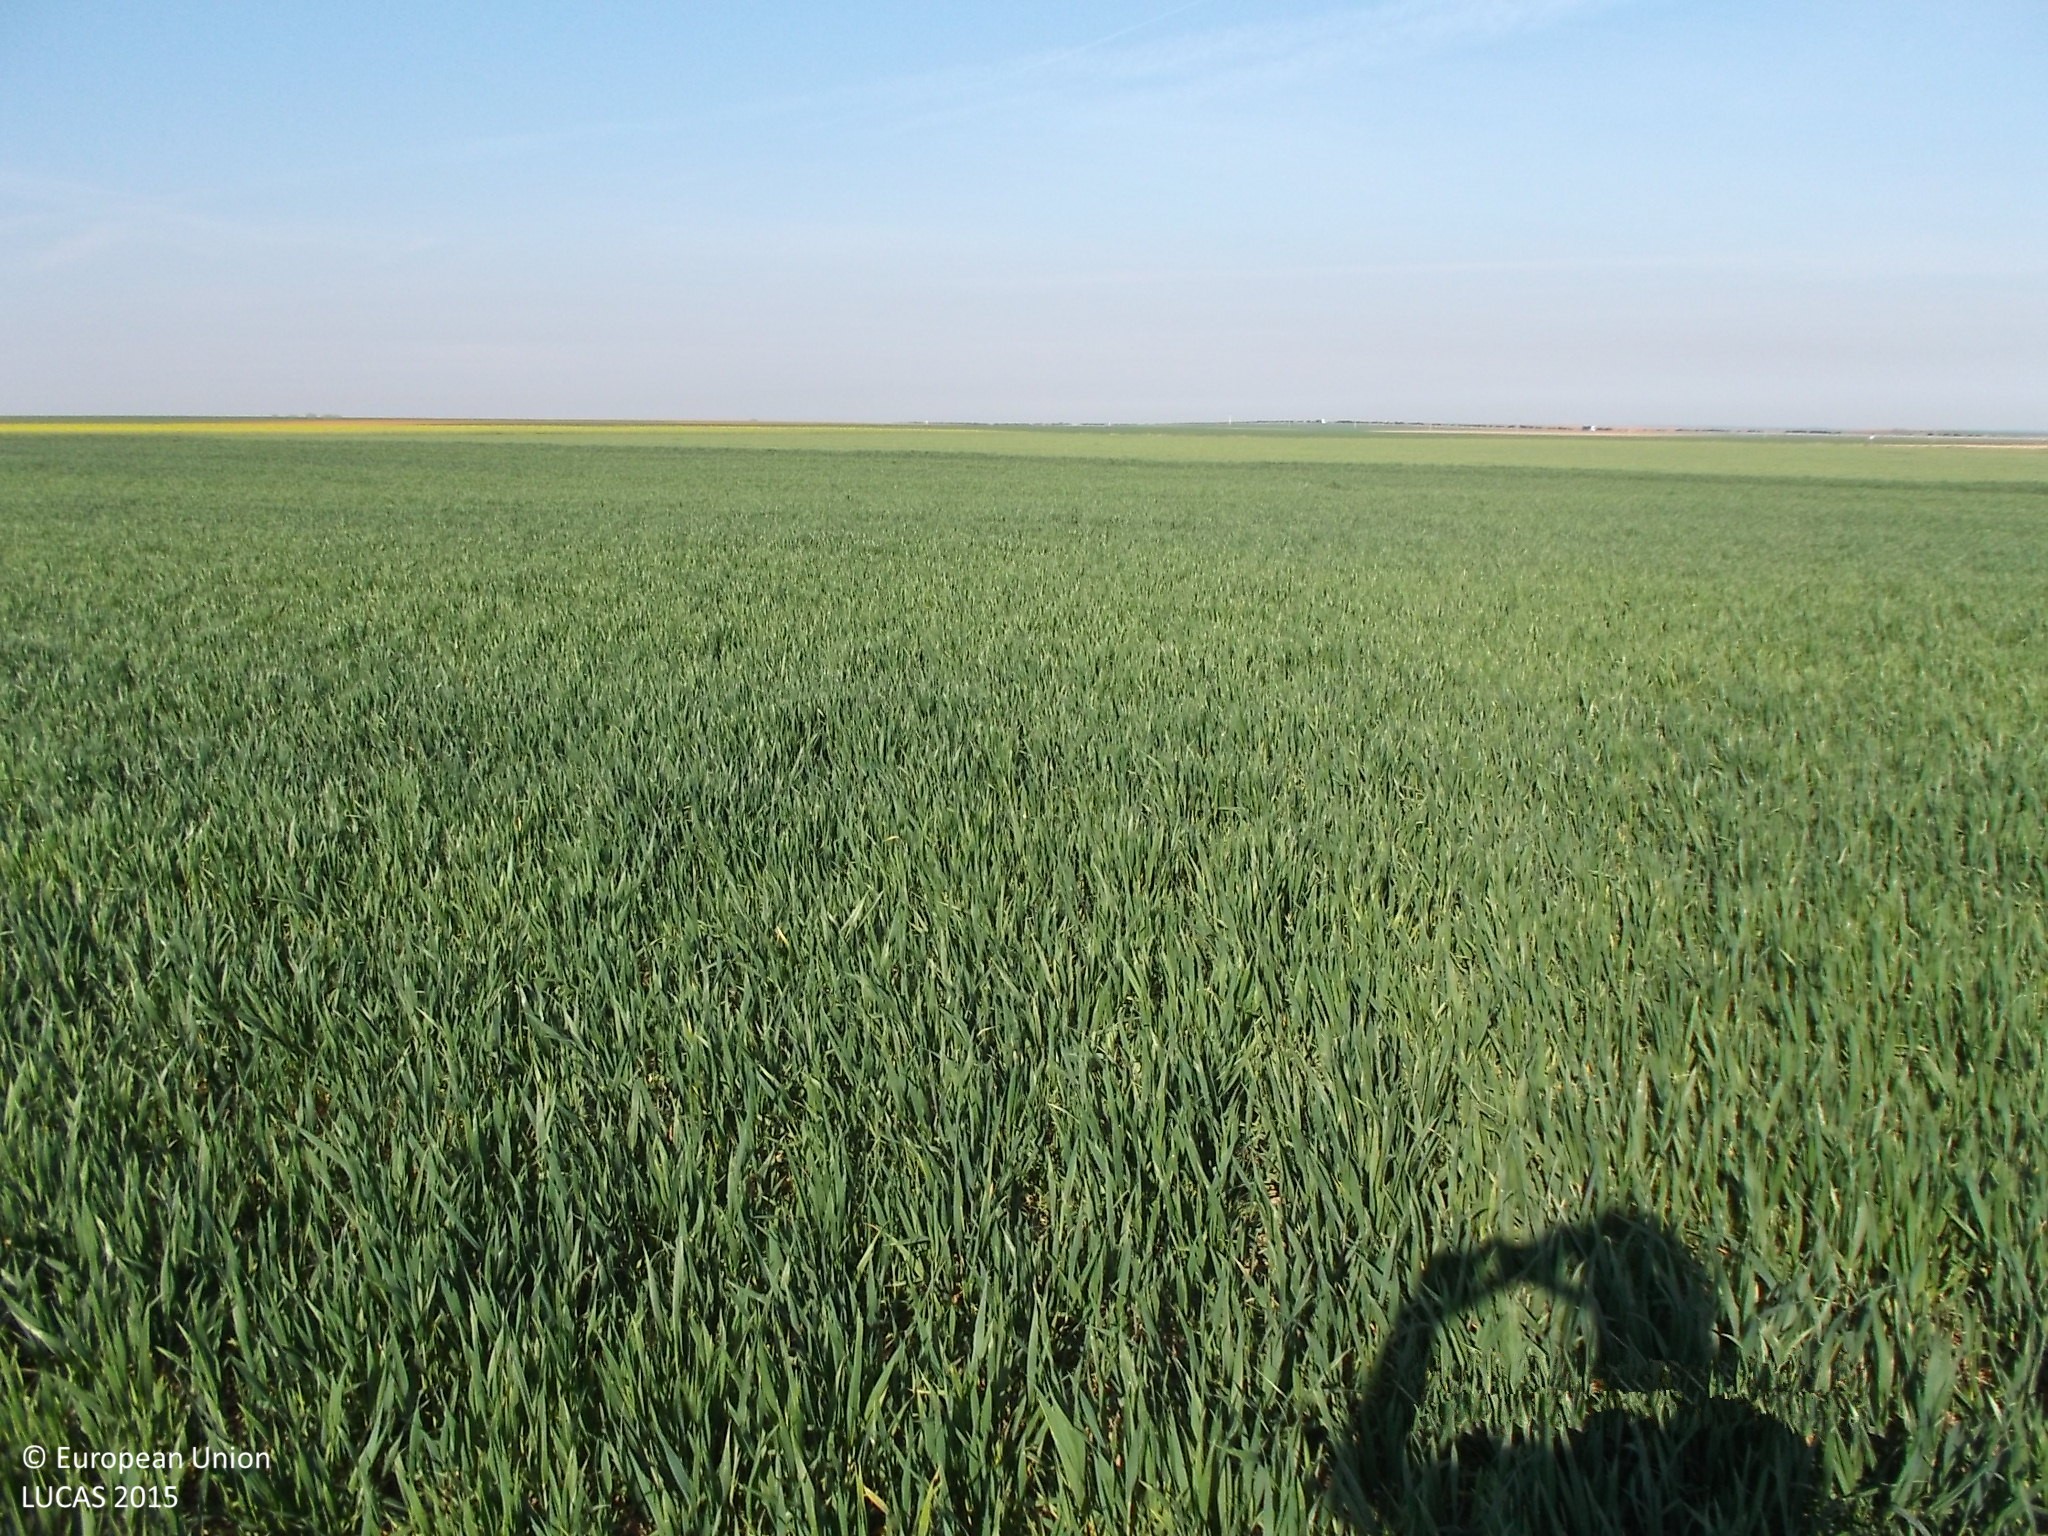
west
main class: Cropland
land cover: Common wheat
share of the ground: > 75 %
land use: Agriculture (excluding fallow land and kitchen gardens)
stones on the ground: 10 - 25 %
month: April
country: ES
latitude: 40.8921
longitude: -5.9025
